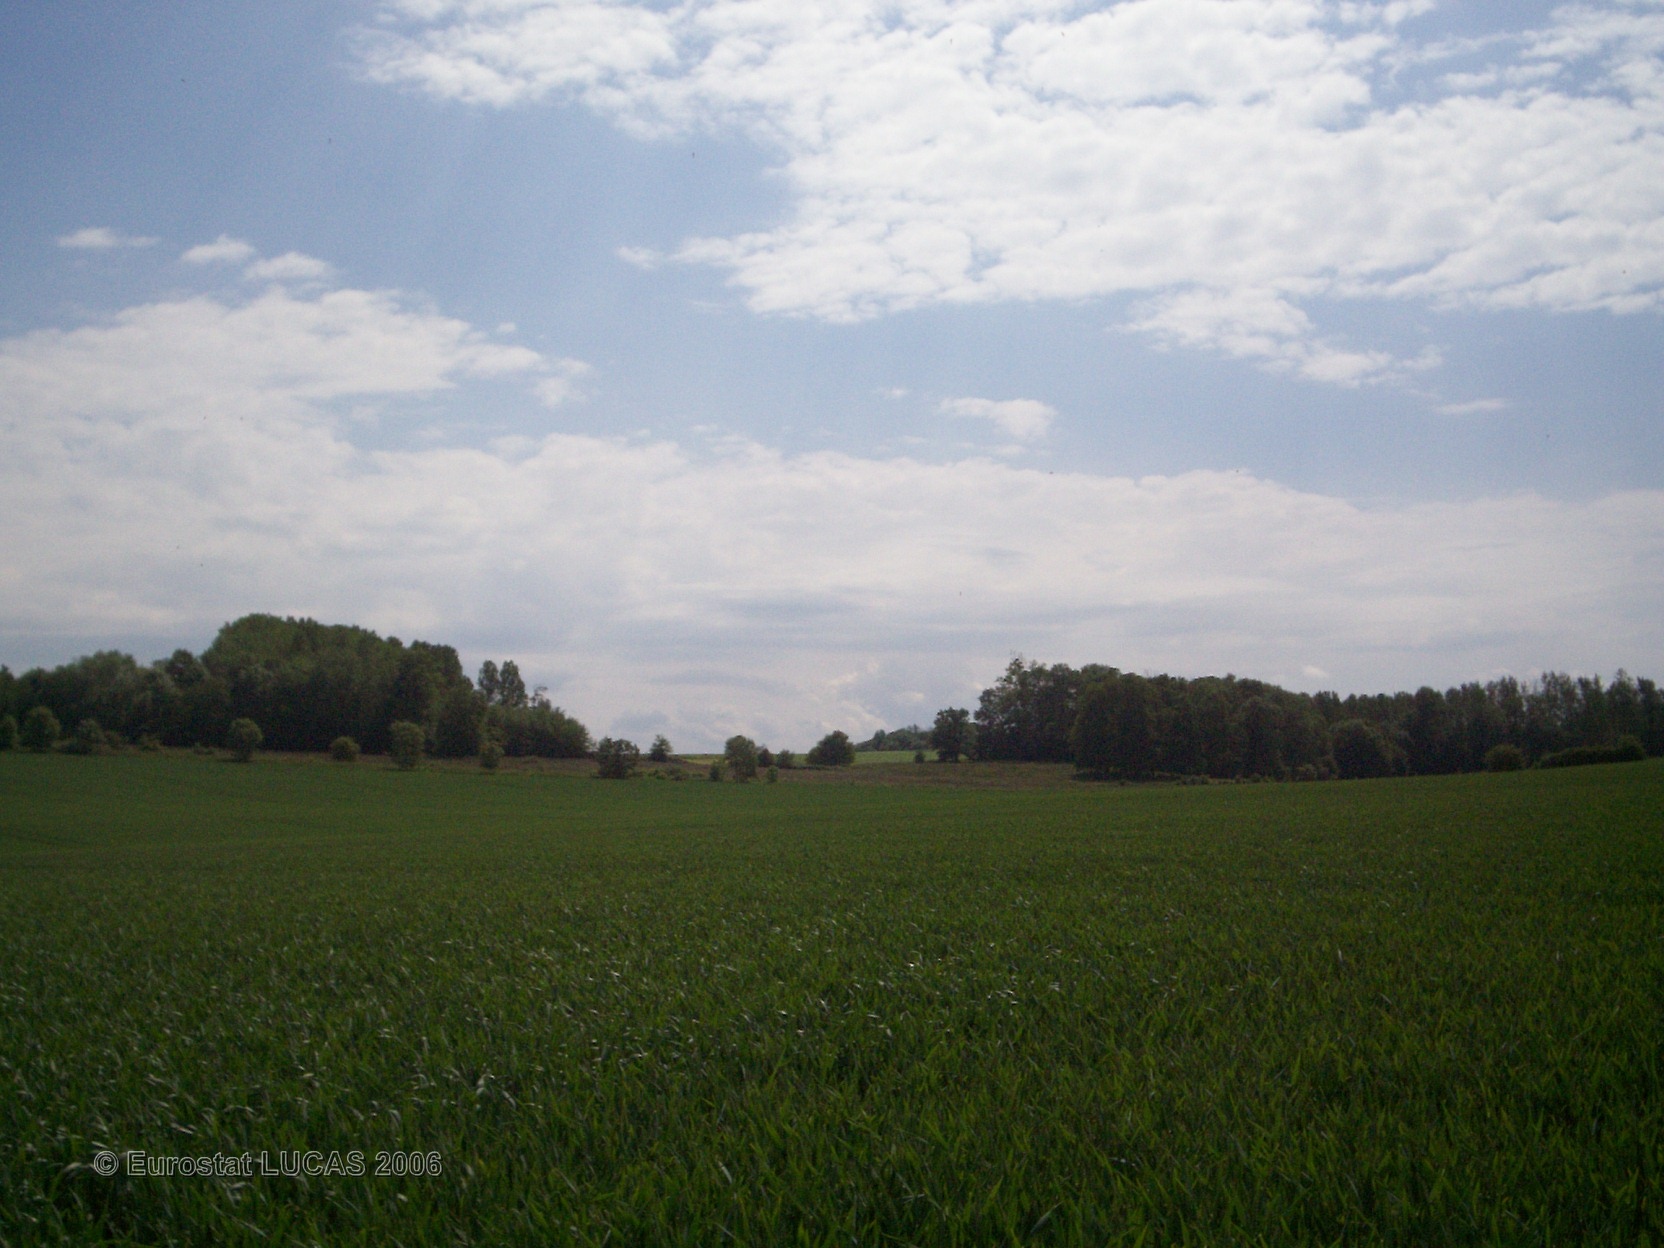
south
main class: Cropland
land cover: Common wheat
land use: Agriculture (excluding fallow land and kitchen gardens)
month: June
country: FR
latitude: 49.4100
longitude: 2.7258
